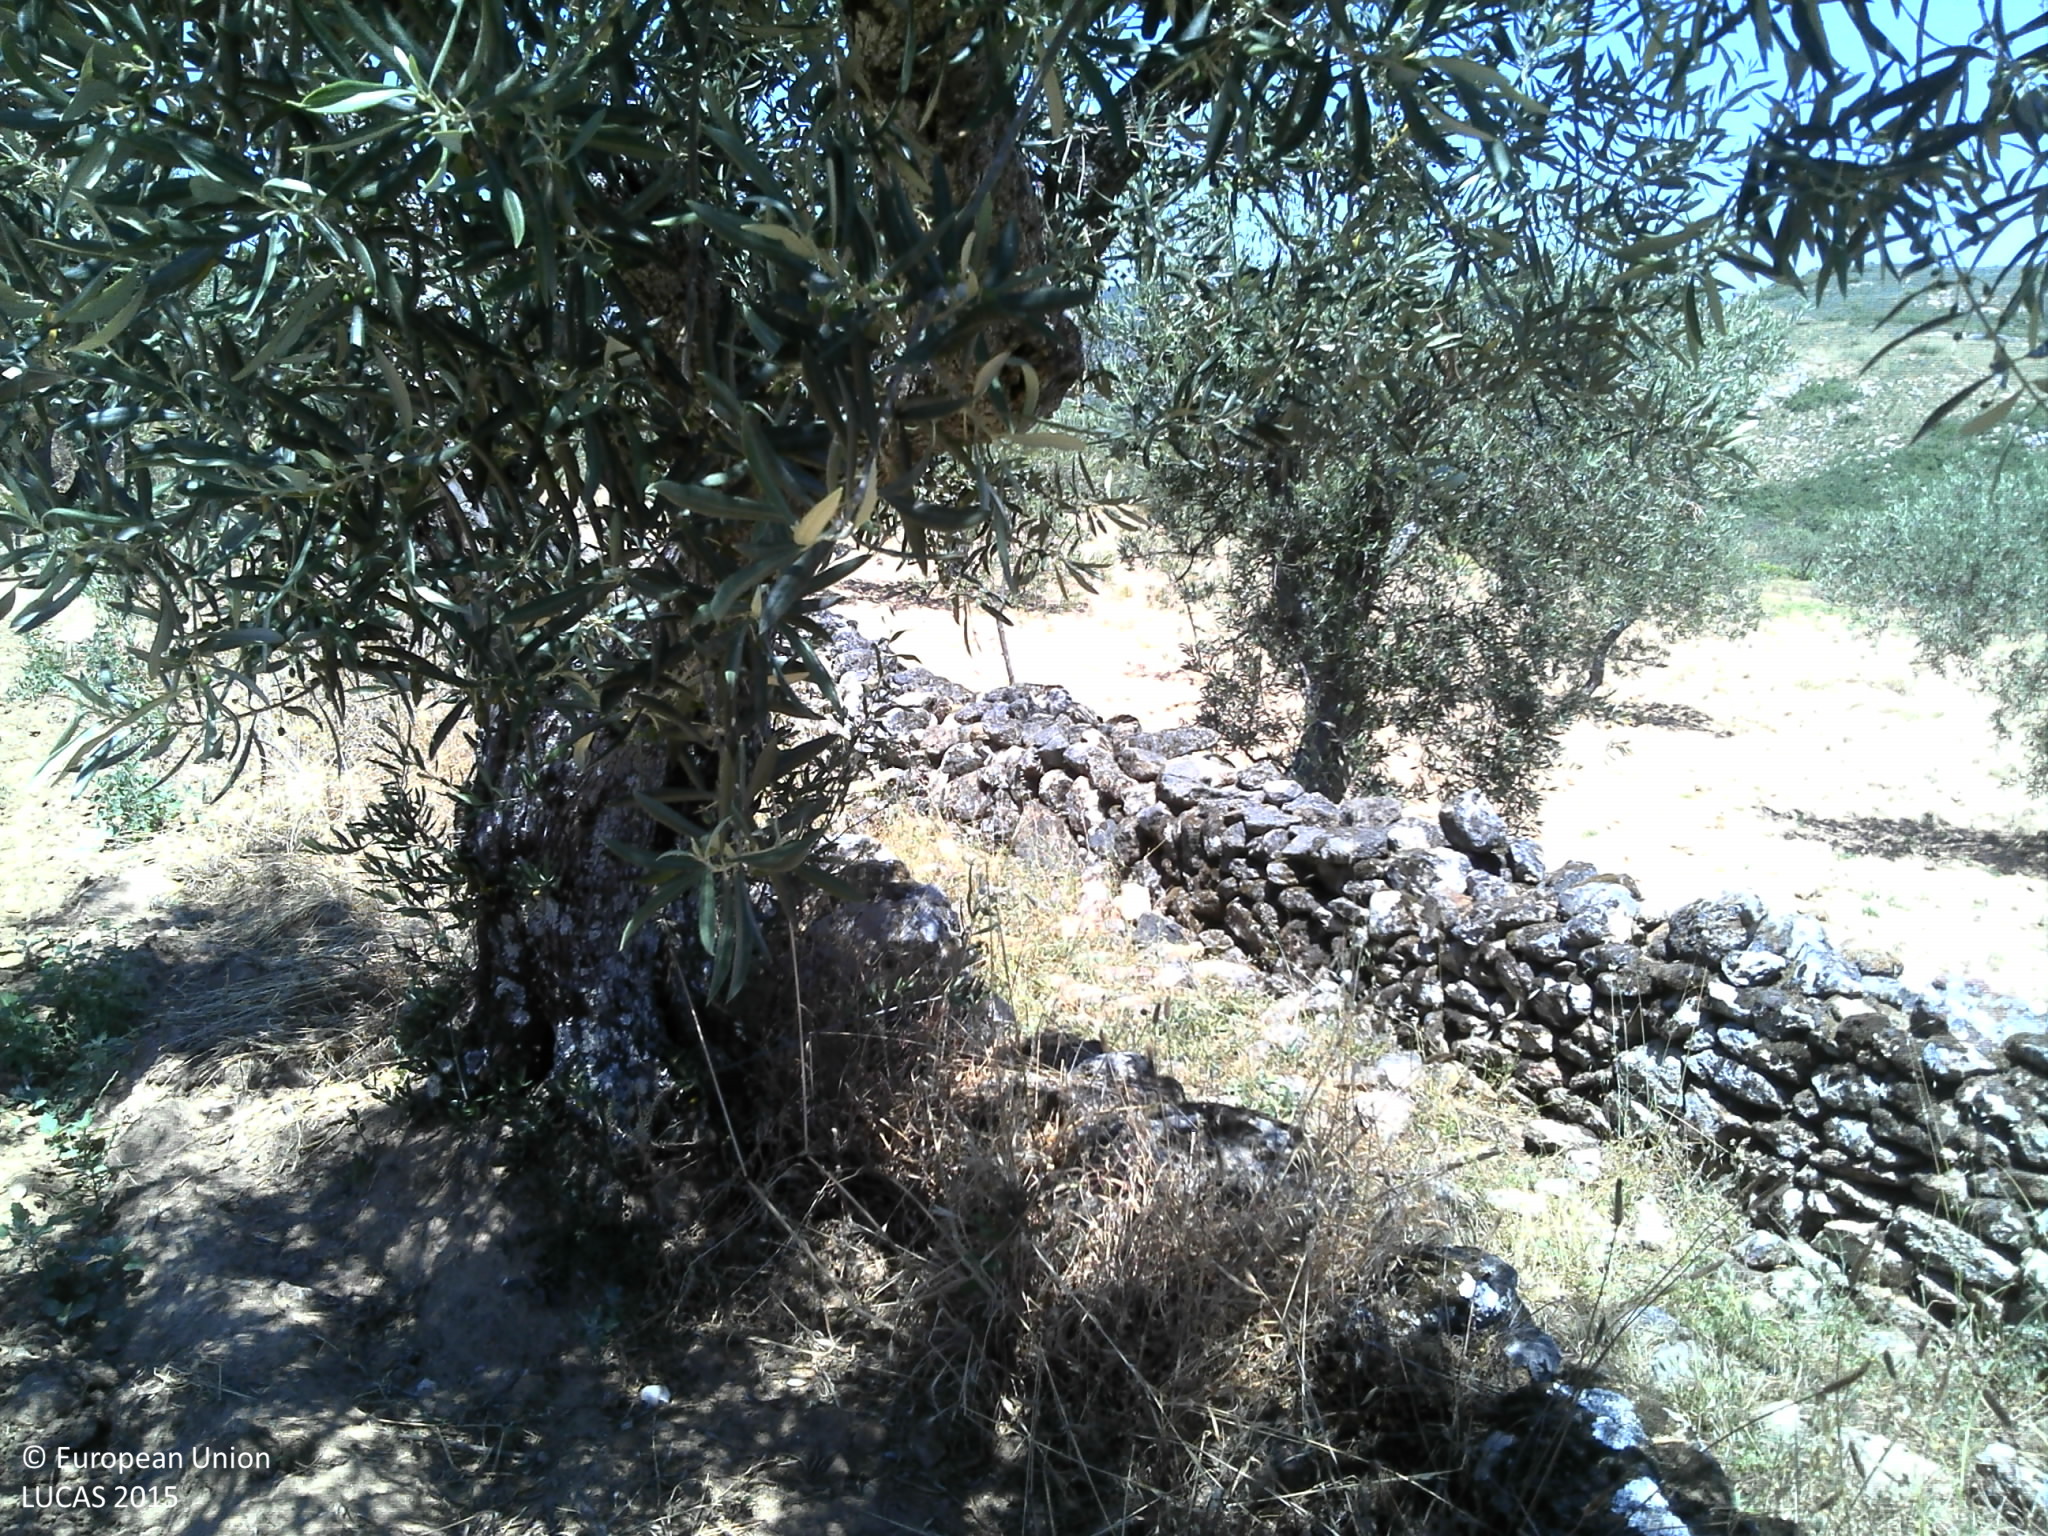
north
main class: Cropland
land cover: Olive groves
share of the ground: 25 - 50 %
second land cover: Other bare soil
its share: > 75 %
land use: Agriculture (excluding fallow land and kitchen gardens)
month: June
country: PT
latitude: 40.8041
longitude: -7.2864
